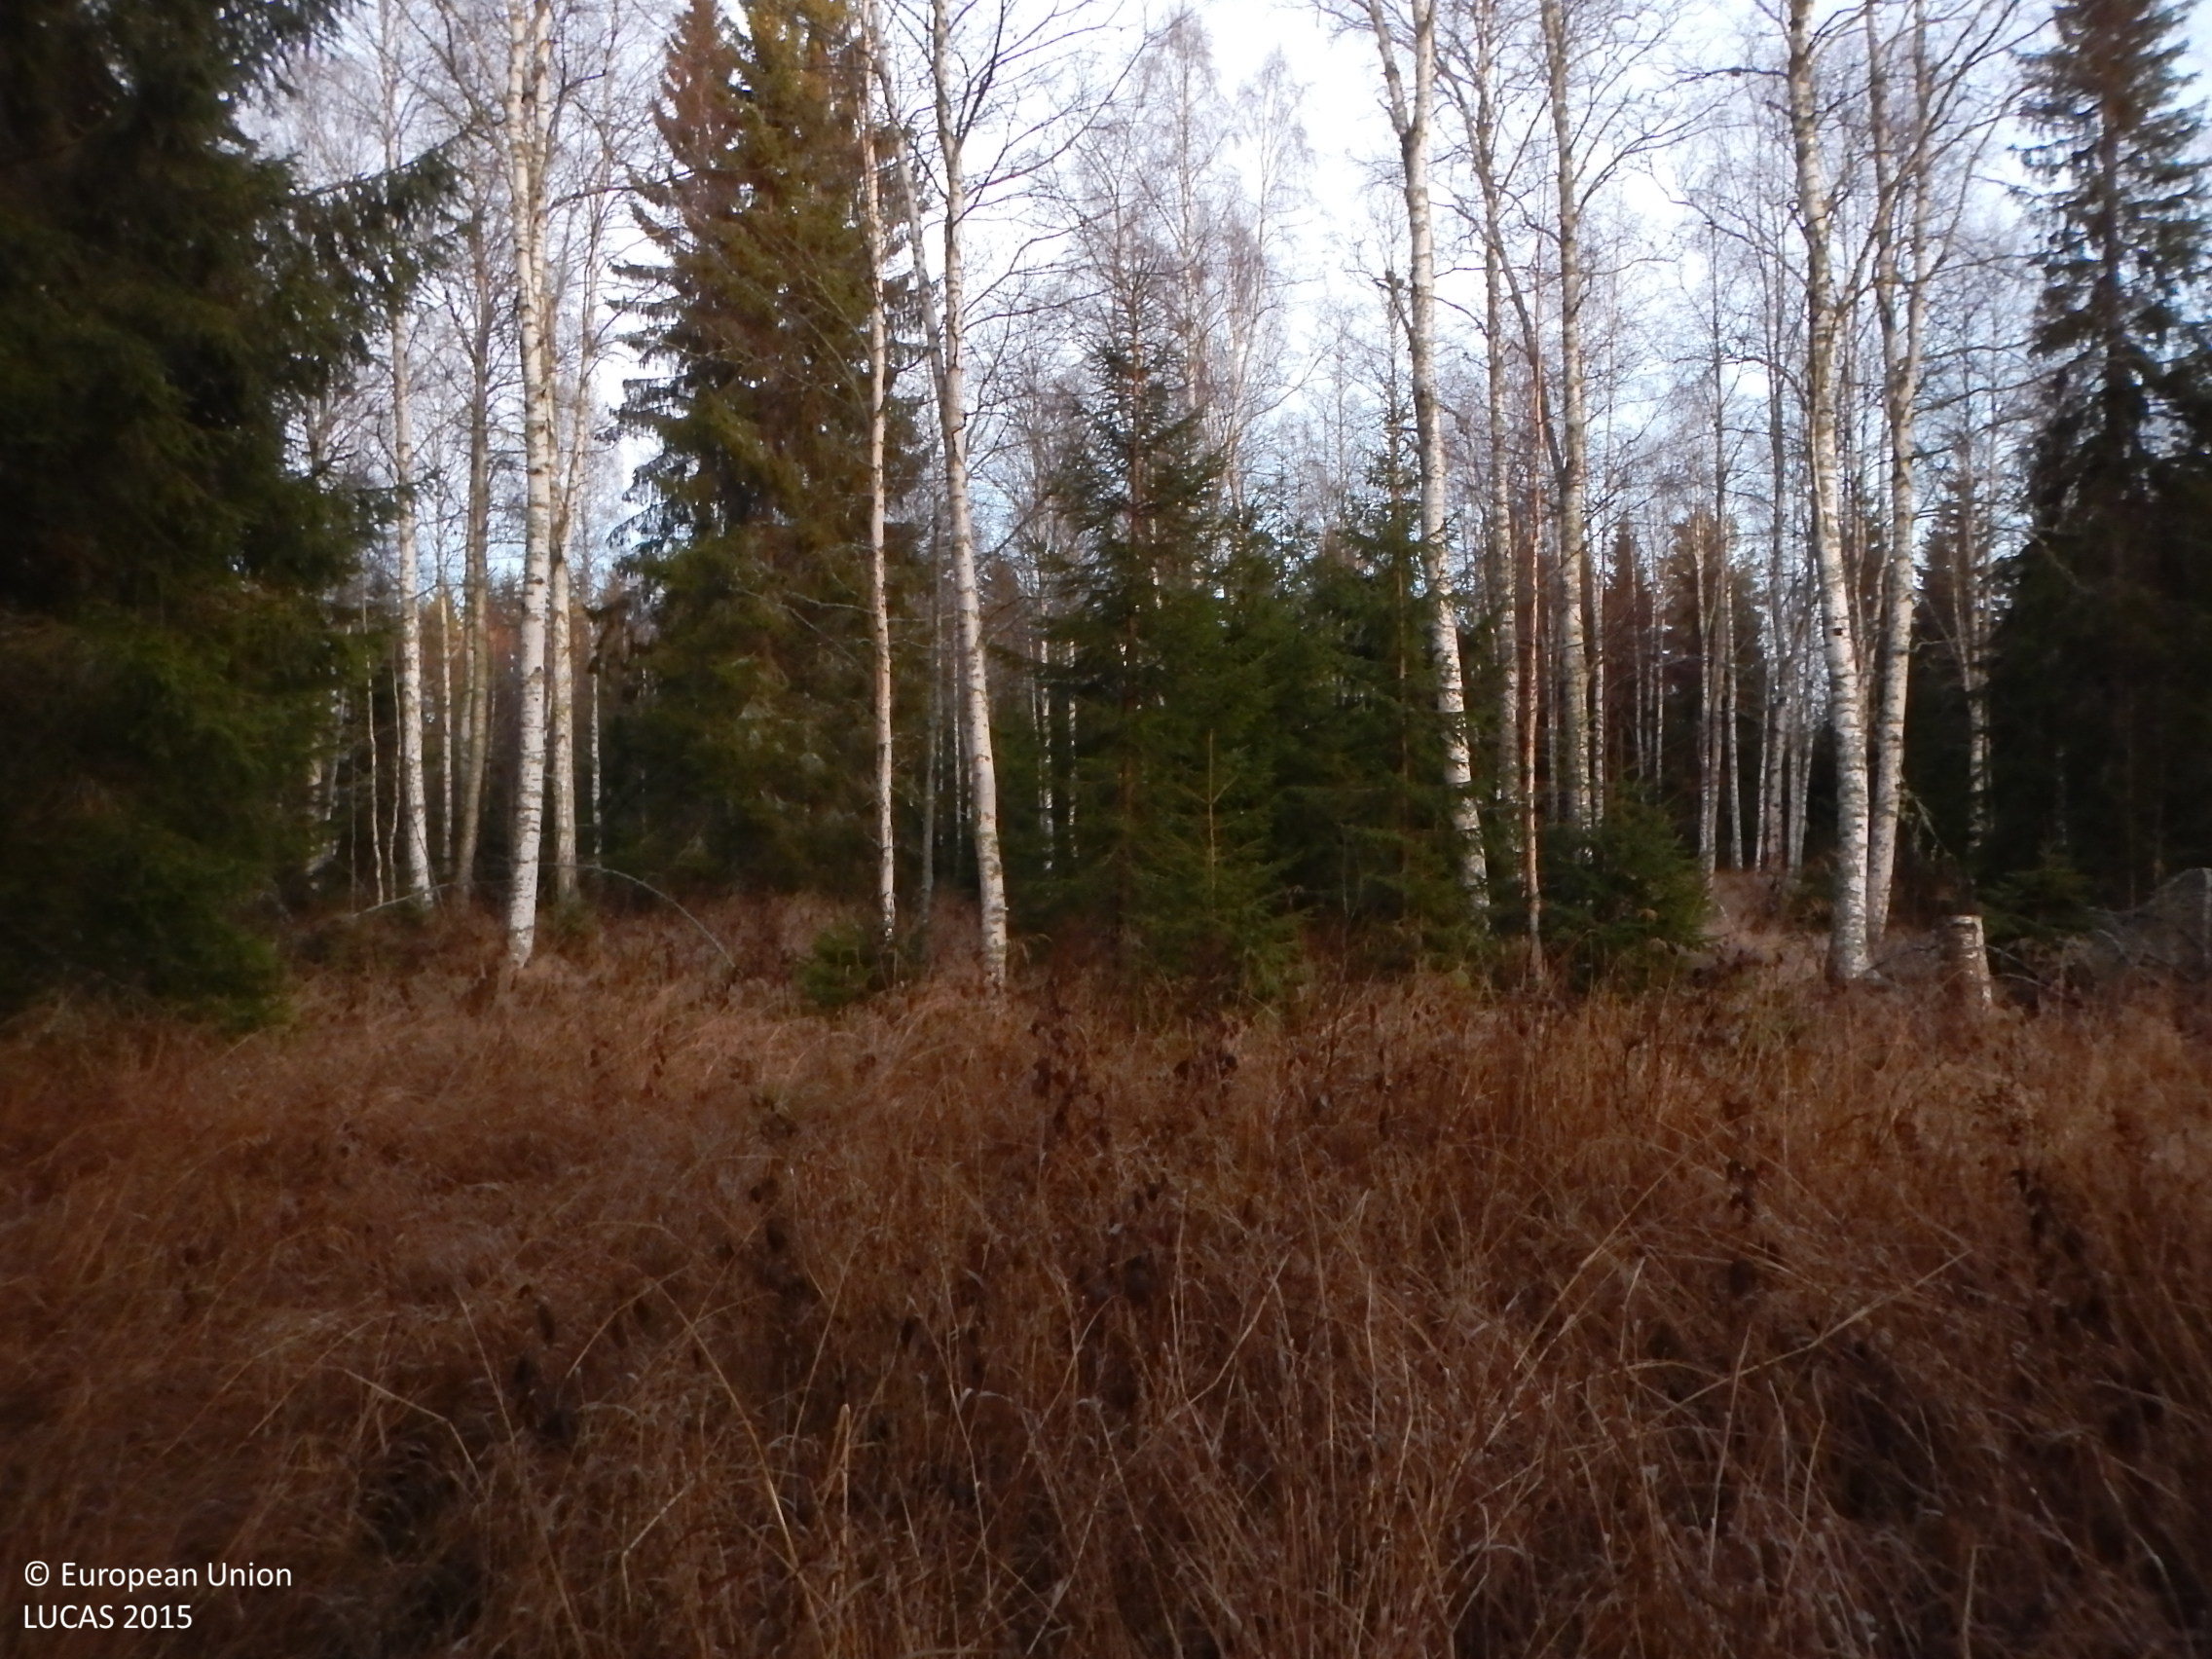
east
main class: Woodland
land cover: Spruce dominated mixed woodland
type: boreal forest
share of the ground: 50 - 75 %
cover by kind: coniferous forest trees 30 %, broadleaved forest trees 30 %, herbaceous plants 30 %, shrubs 10 %
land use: Forestry
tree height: > 5 m
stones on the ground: < 10 %
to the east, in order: Spruce dominated mixed woodland; Ditches and canals; Spruce dominated mixed woodland; Ditches and canals; Spruce dominated mixed woodland; Ditches and canals; Spruce dominated mixed woodland; Ditches and canals; Spruce dominated mixed woodland; Shrubland with sparse tree cover; Electric lines; Tracks; Electric lines; Shrubland with sparse tree cover; Broadleaved woodland; Ditches and canals; Broadleaved woodland
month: November
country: SE
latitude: 61.4035
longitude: 16.1086
